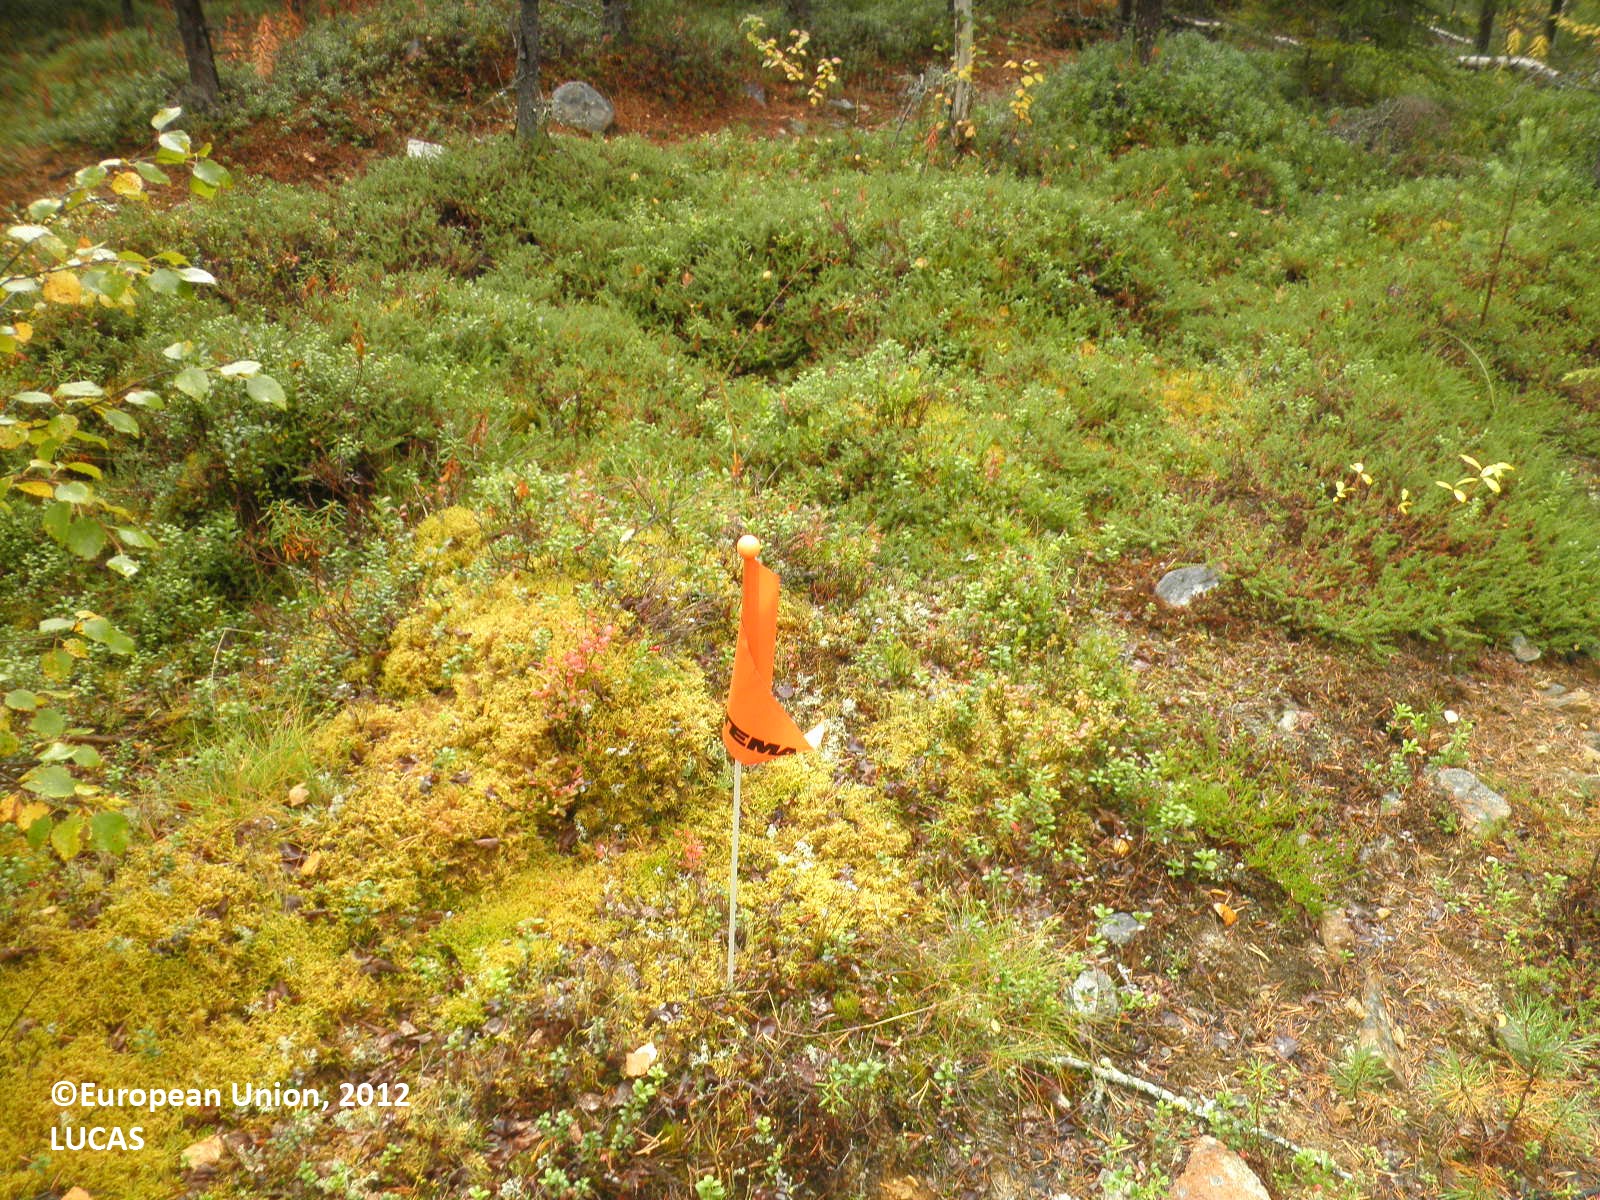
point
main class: Woodland
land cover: Pine dominated coniferous woodland
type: boreal forest
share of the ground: 50 - 75 %
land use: Forestry
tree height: > 5 m
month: September
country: FI
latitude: 67.2414
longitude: 28.1675
